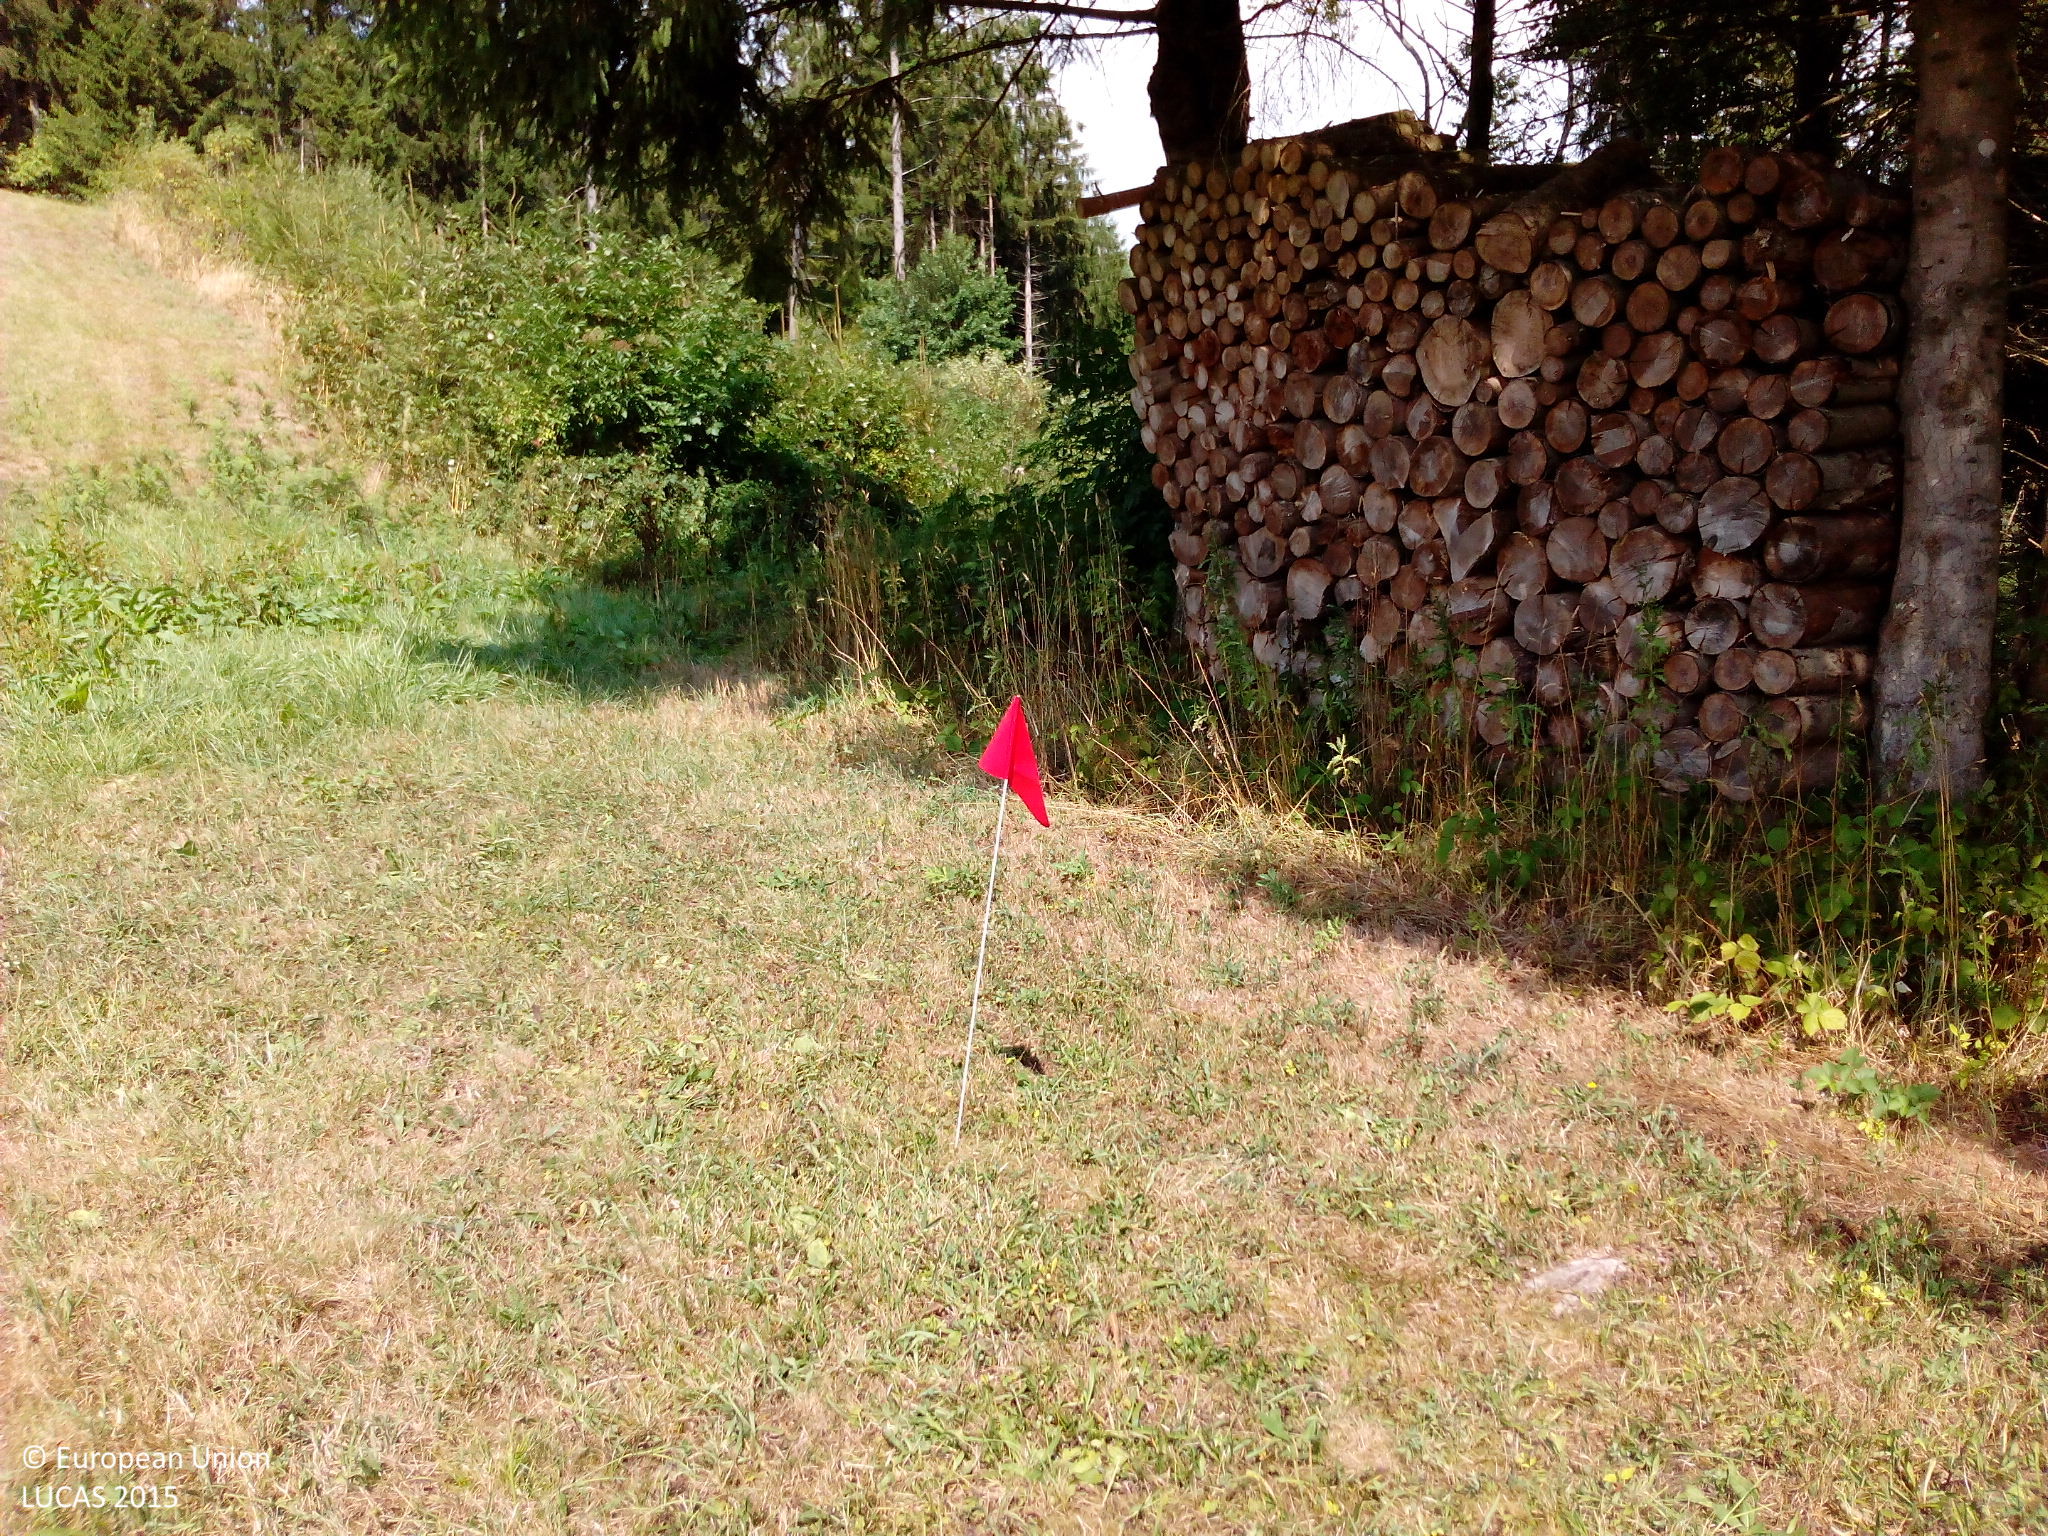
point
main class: Grassland
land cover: Grassland without tree/shrub cover
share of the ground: > 75 %
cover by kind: herbaceous plants 100 %
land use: Agriculture (excluding fallow land and kitchen gardens)
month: August
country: DE
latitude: 47.6495
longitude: 8.1242
